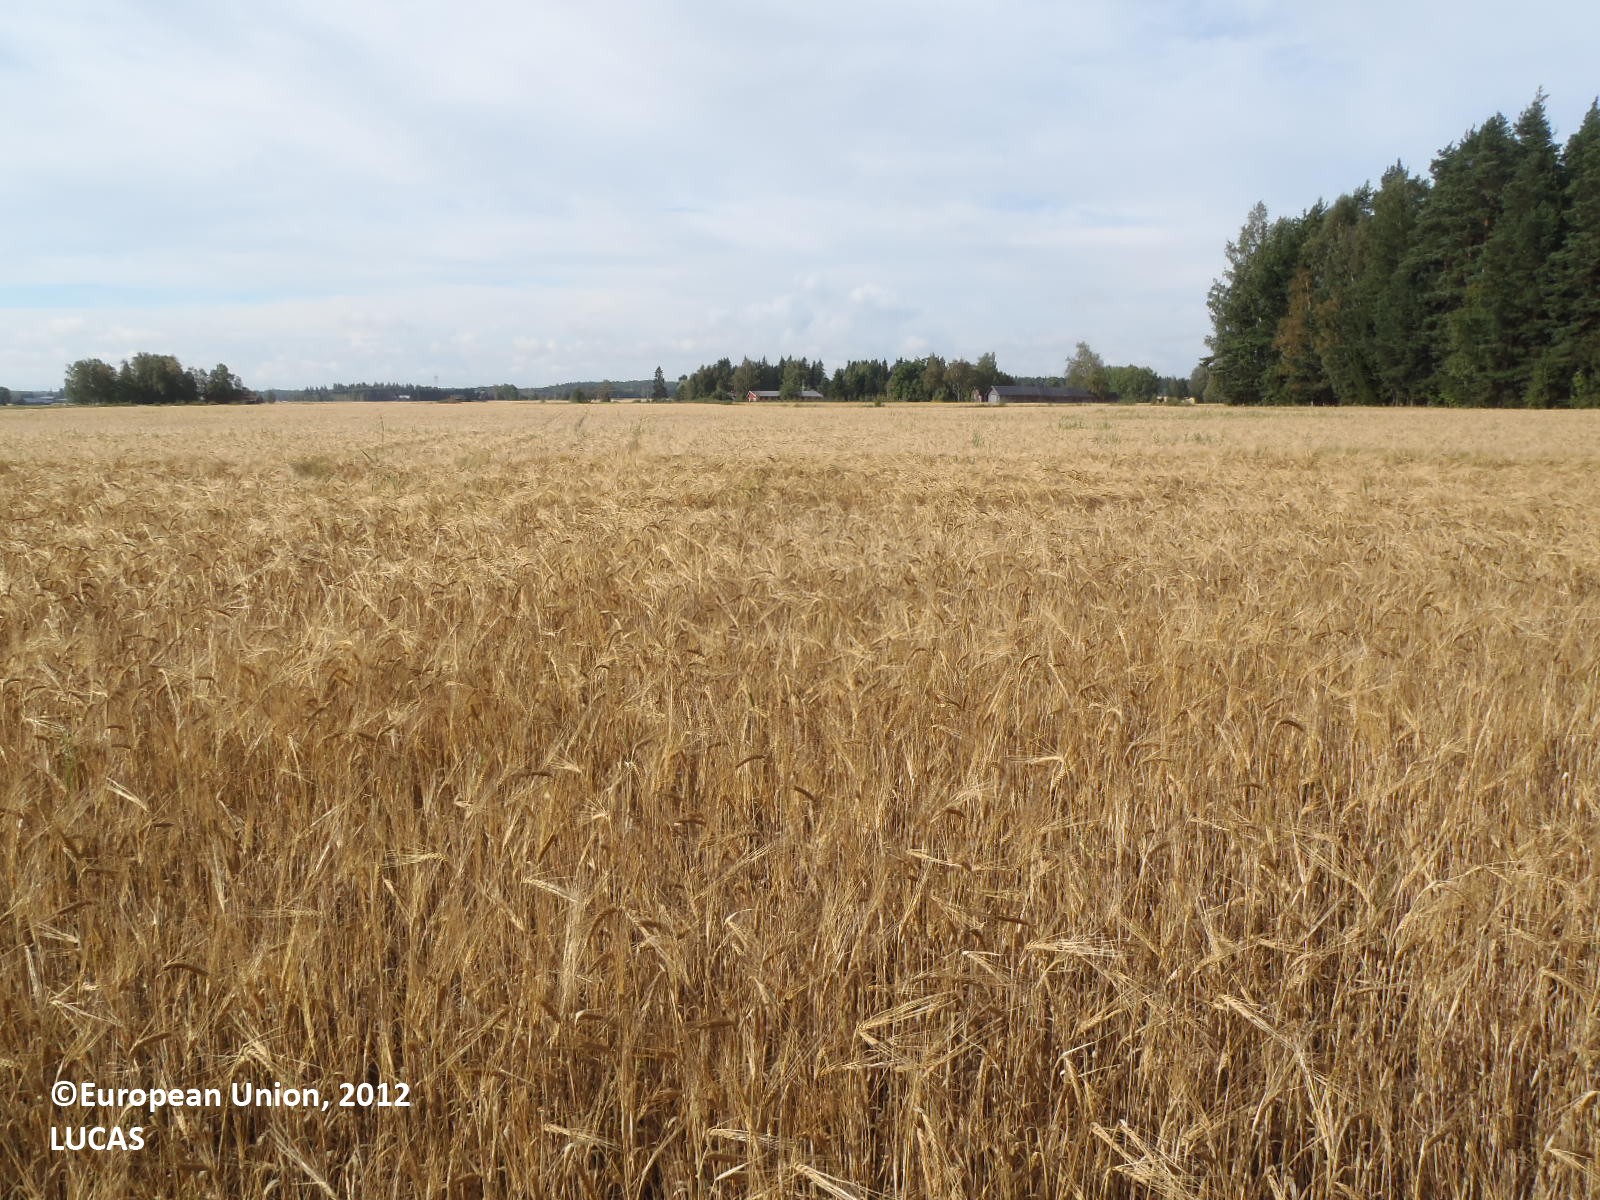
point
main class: Cropland
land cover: Barley
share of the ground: > 75 %
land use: Agriculture (excluding fallow land and kitchen gardens)
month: August
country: FI
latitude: 60.6262
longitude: 22.2934
